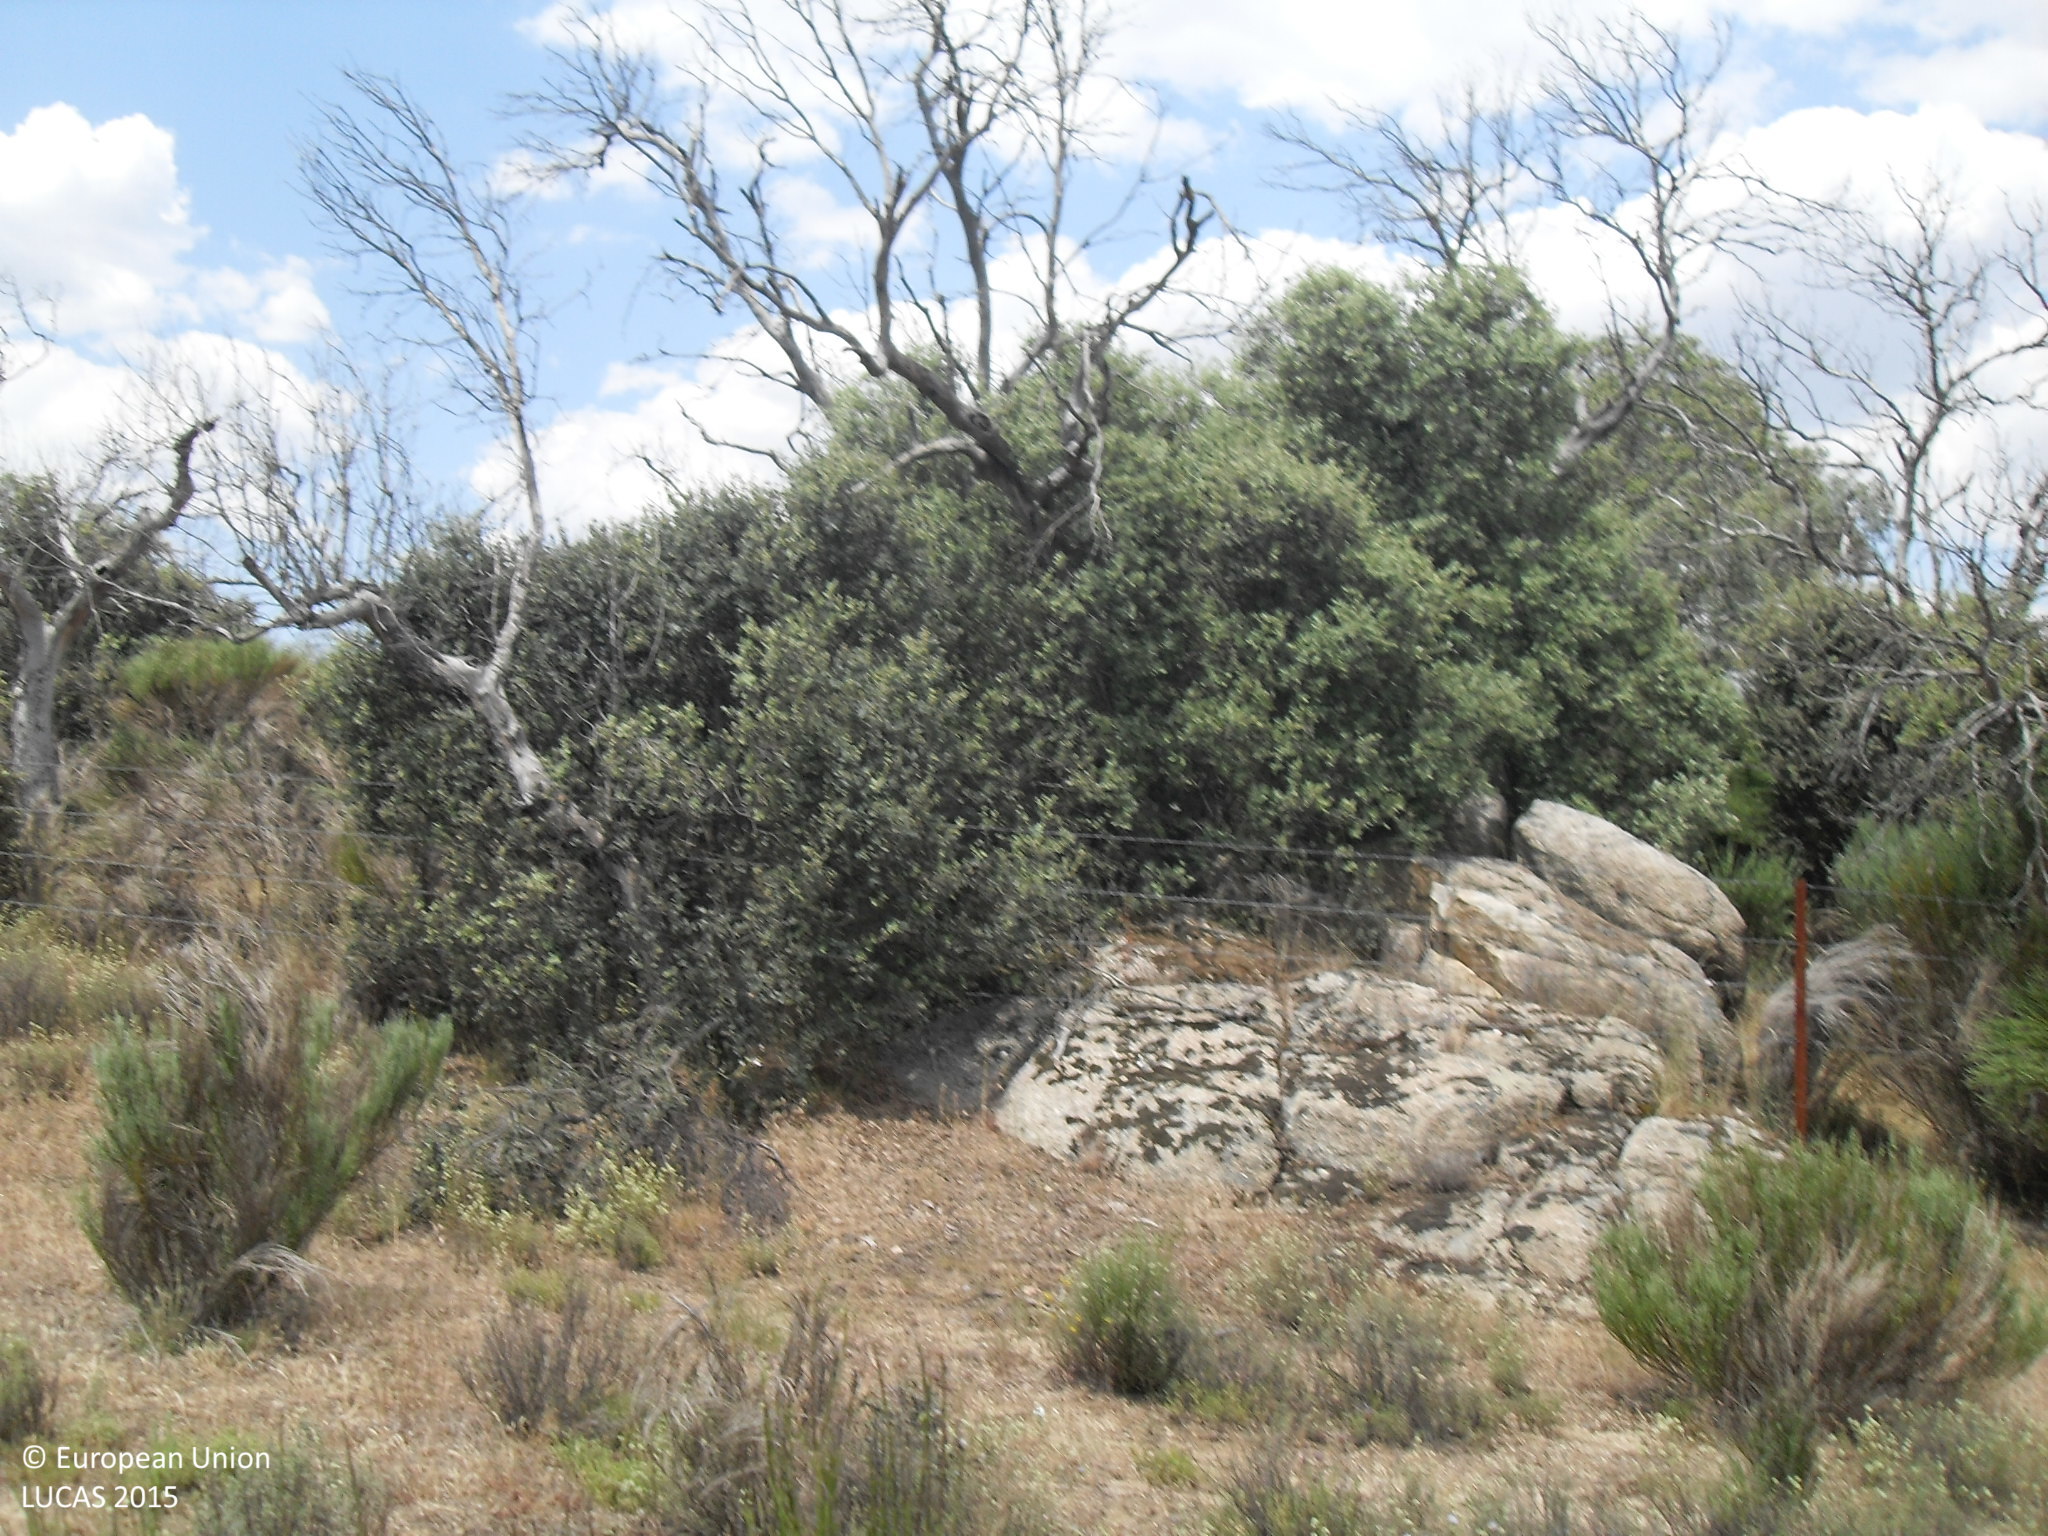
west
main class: Shrubland
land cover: Shrubland without tree cover
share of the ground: > 75 %
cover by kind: shrubs 60 %, herbaceous plants 40 %
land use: Abandoned areas
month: June
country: ES
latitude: 40.4491
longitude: -5.5729
